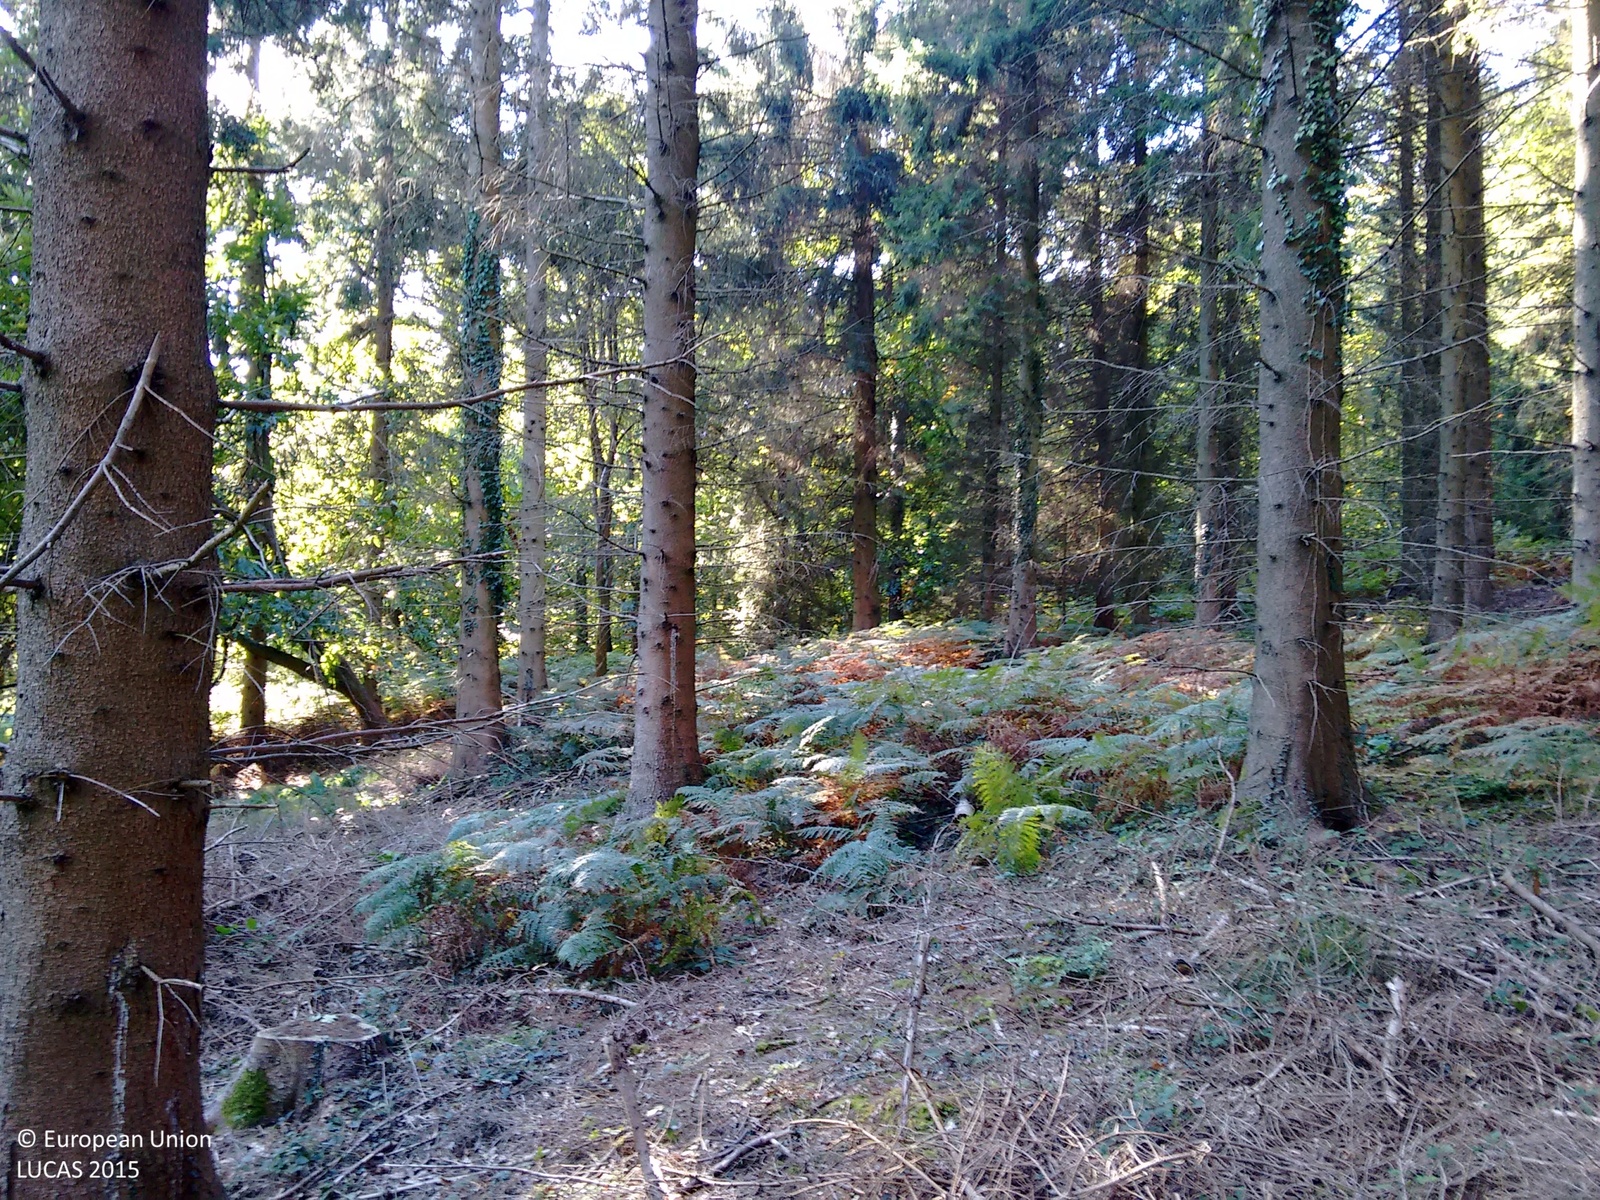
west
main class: Woodland
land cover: Spruce dominated coniferous woodland
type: exotic forest
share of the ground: > 75 %
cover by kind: coniferous forest trees 70 %, herbaceous plants 30 %
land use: Forestry
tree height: > 5 m
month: September
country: GB
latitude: 51.8373
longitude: -2.5338
